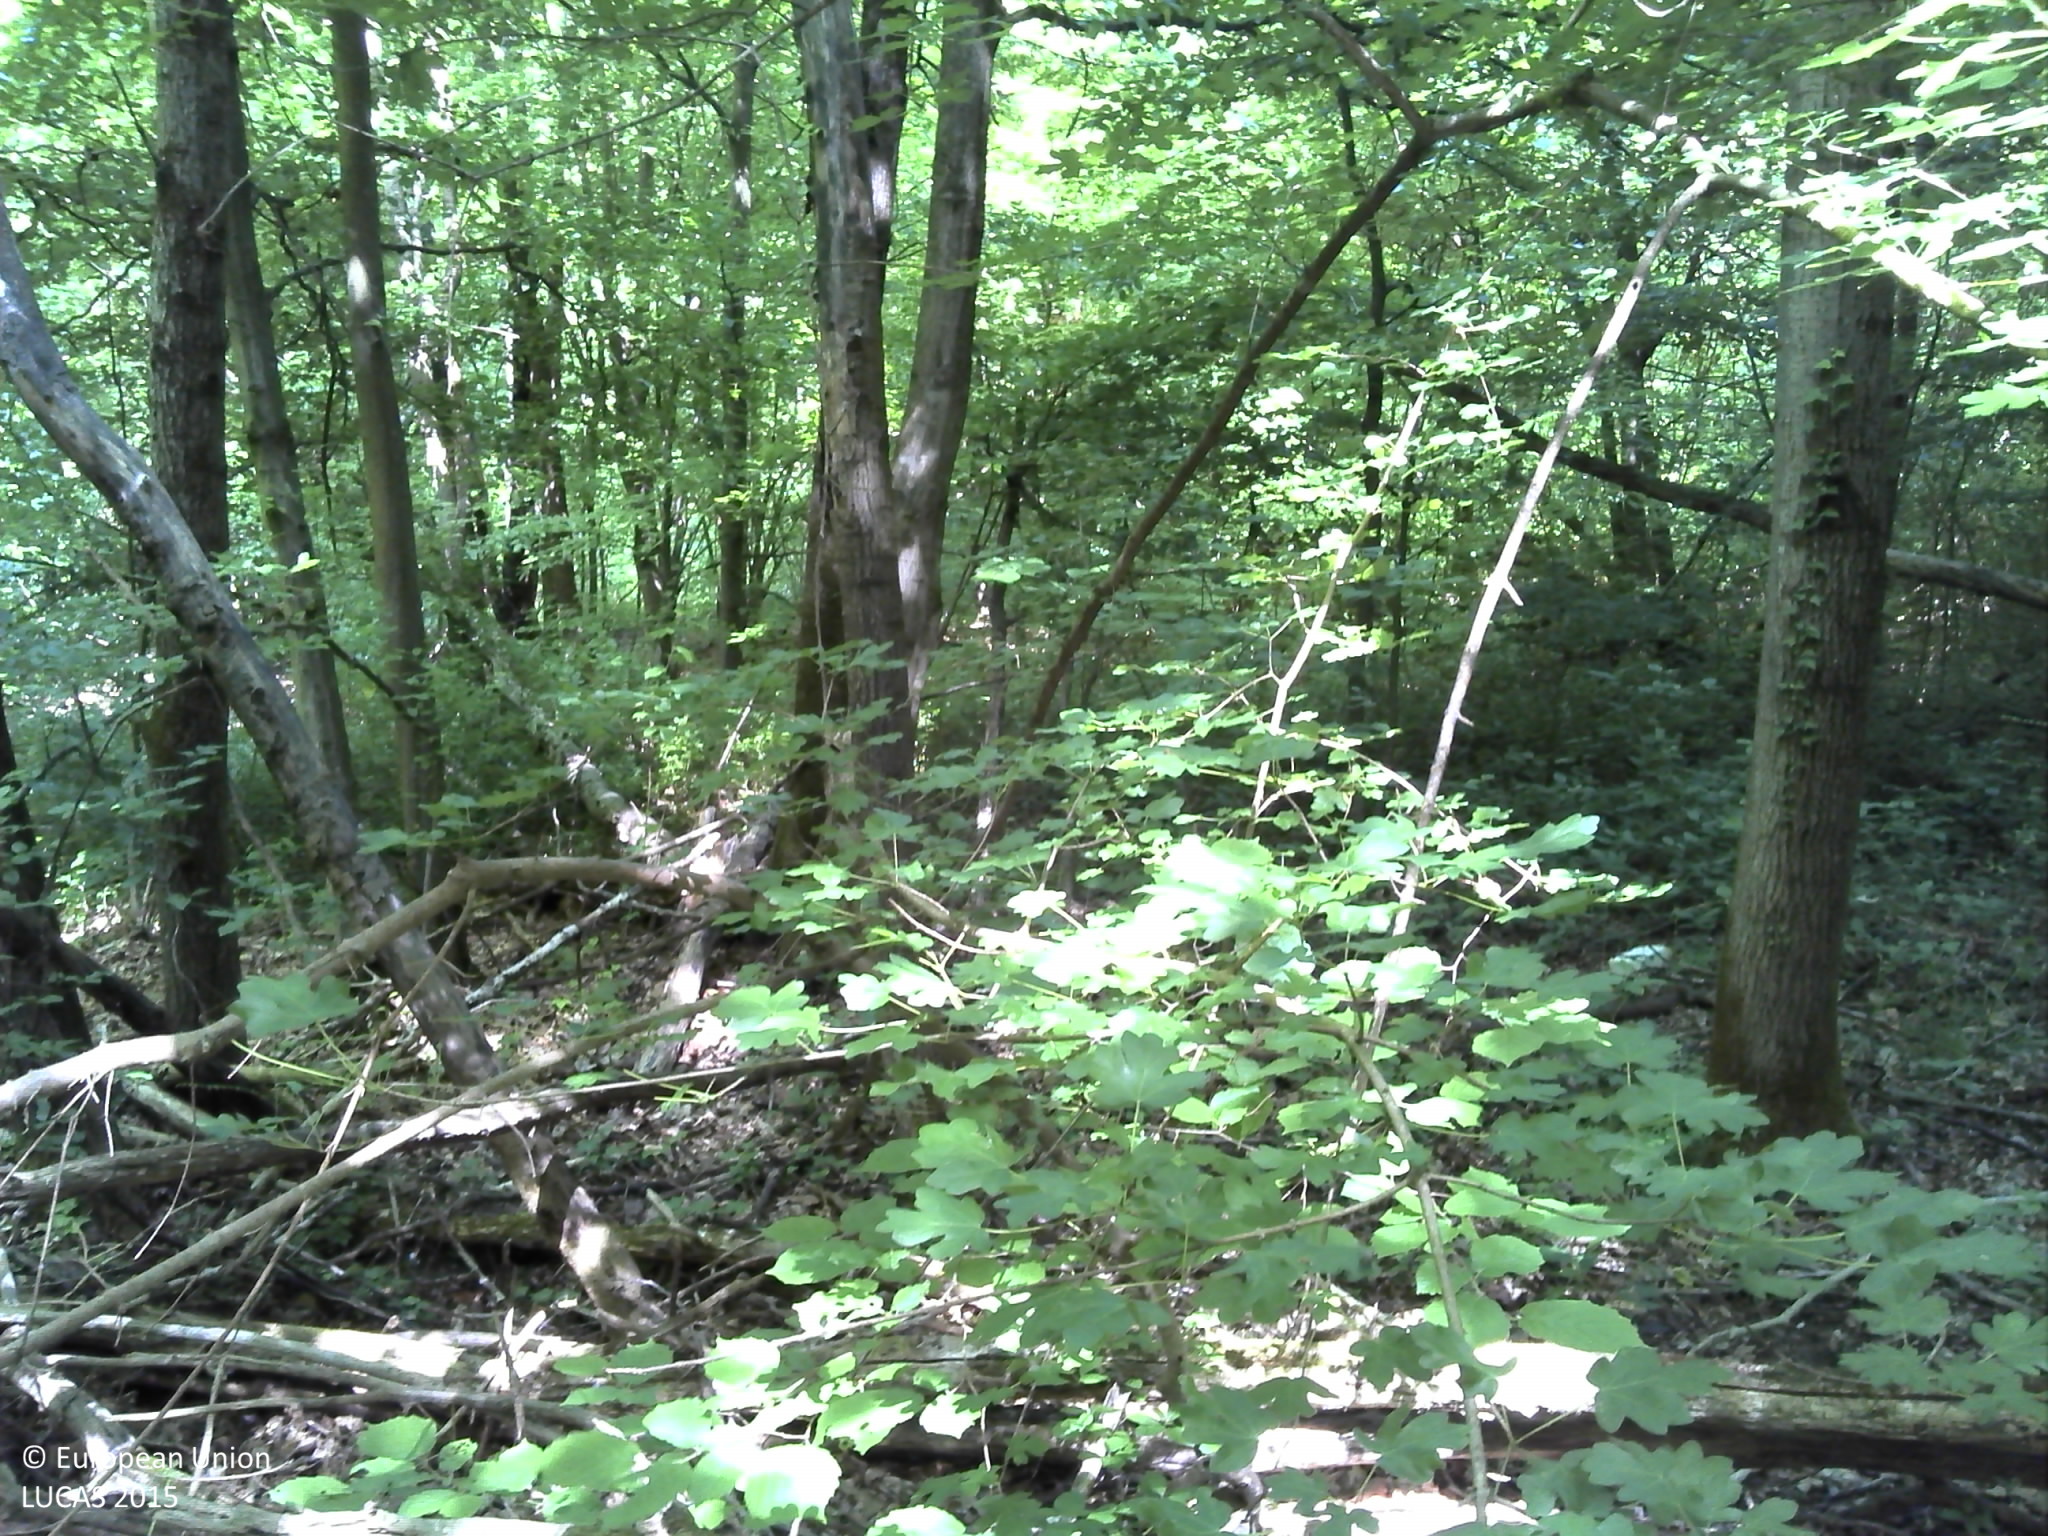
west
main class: Woodland
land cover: Broadleaved woodland
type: beech forest
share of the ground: > 75 %
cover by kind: broadleaved forest trees 100 %
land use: Forestry
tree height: > 5 m
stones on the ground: < 10 %
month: May
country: HR
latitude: 45.4504
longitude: 18.0464
